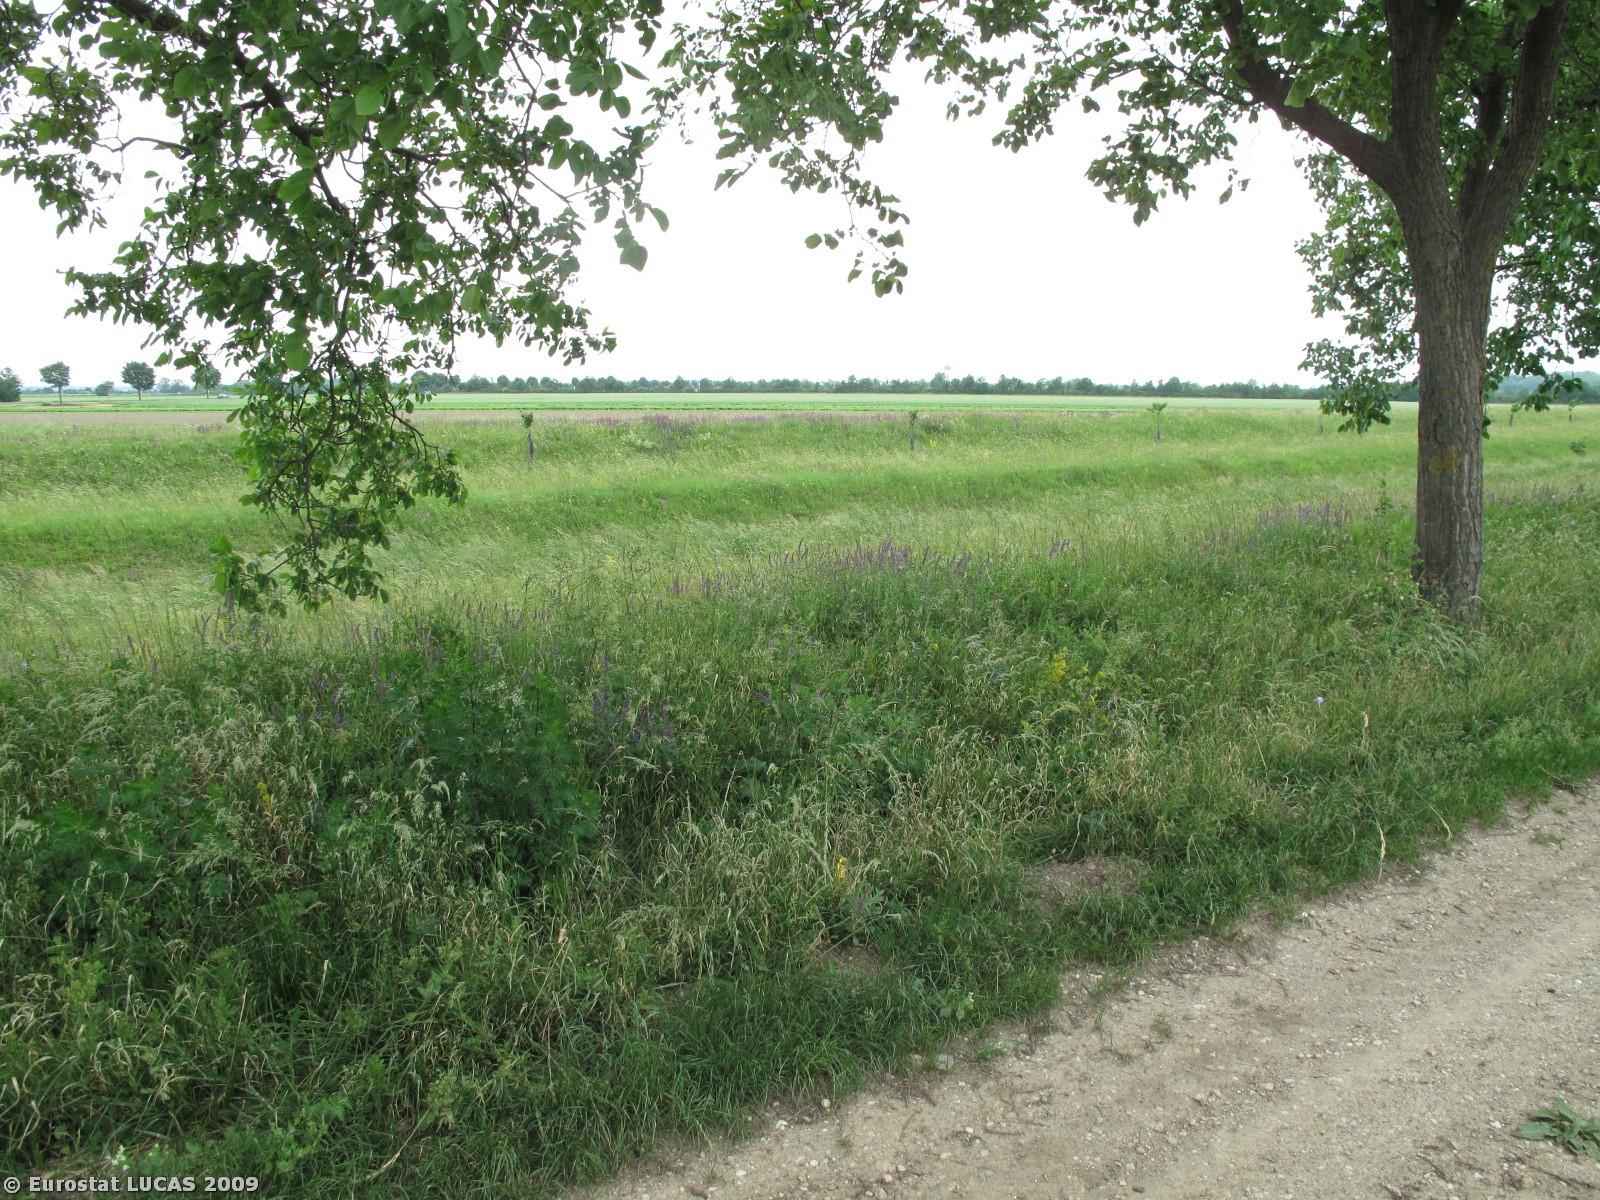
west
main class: Cropland
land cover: Common wheat
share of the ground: > 75 %
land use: Agriculture (excluding fallow land and kitchen gardens)
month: May
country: AT
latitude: 48.4021
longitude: 16.0151
